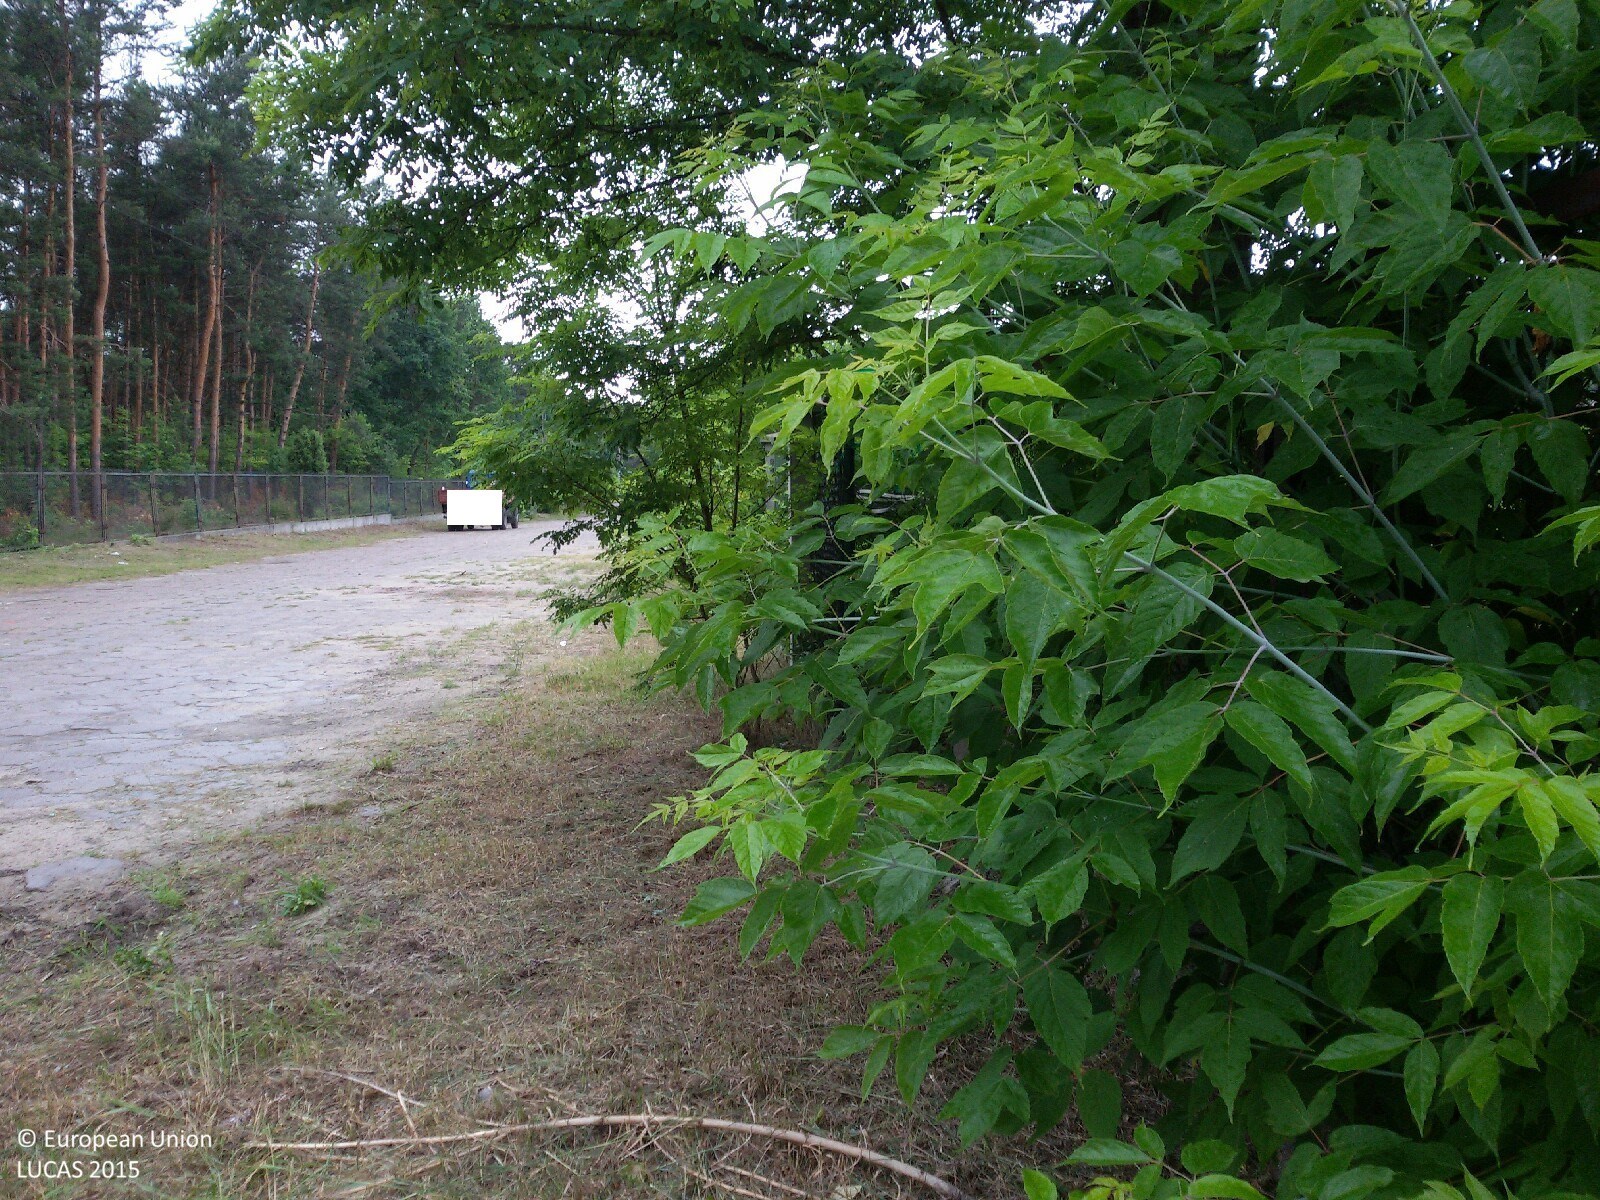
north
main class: Woodland
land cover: Pine dominated mixed woodland
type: hemiboreal forest and nemoral coniferous forest and mixed broadleaved-coniferous forest
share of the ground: > 75 %
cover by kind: coniferous forest trees 50 %, broadleaved forest trees 40 %, lichens and mosses 10 %
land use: Forestry
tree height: > 5 m
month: June
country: PL
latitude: 52.0956
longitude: 21.2435
